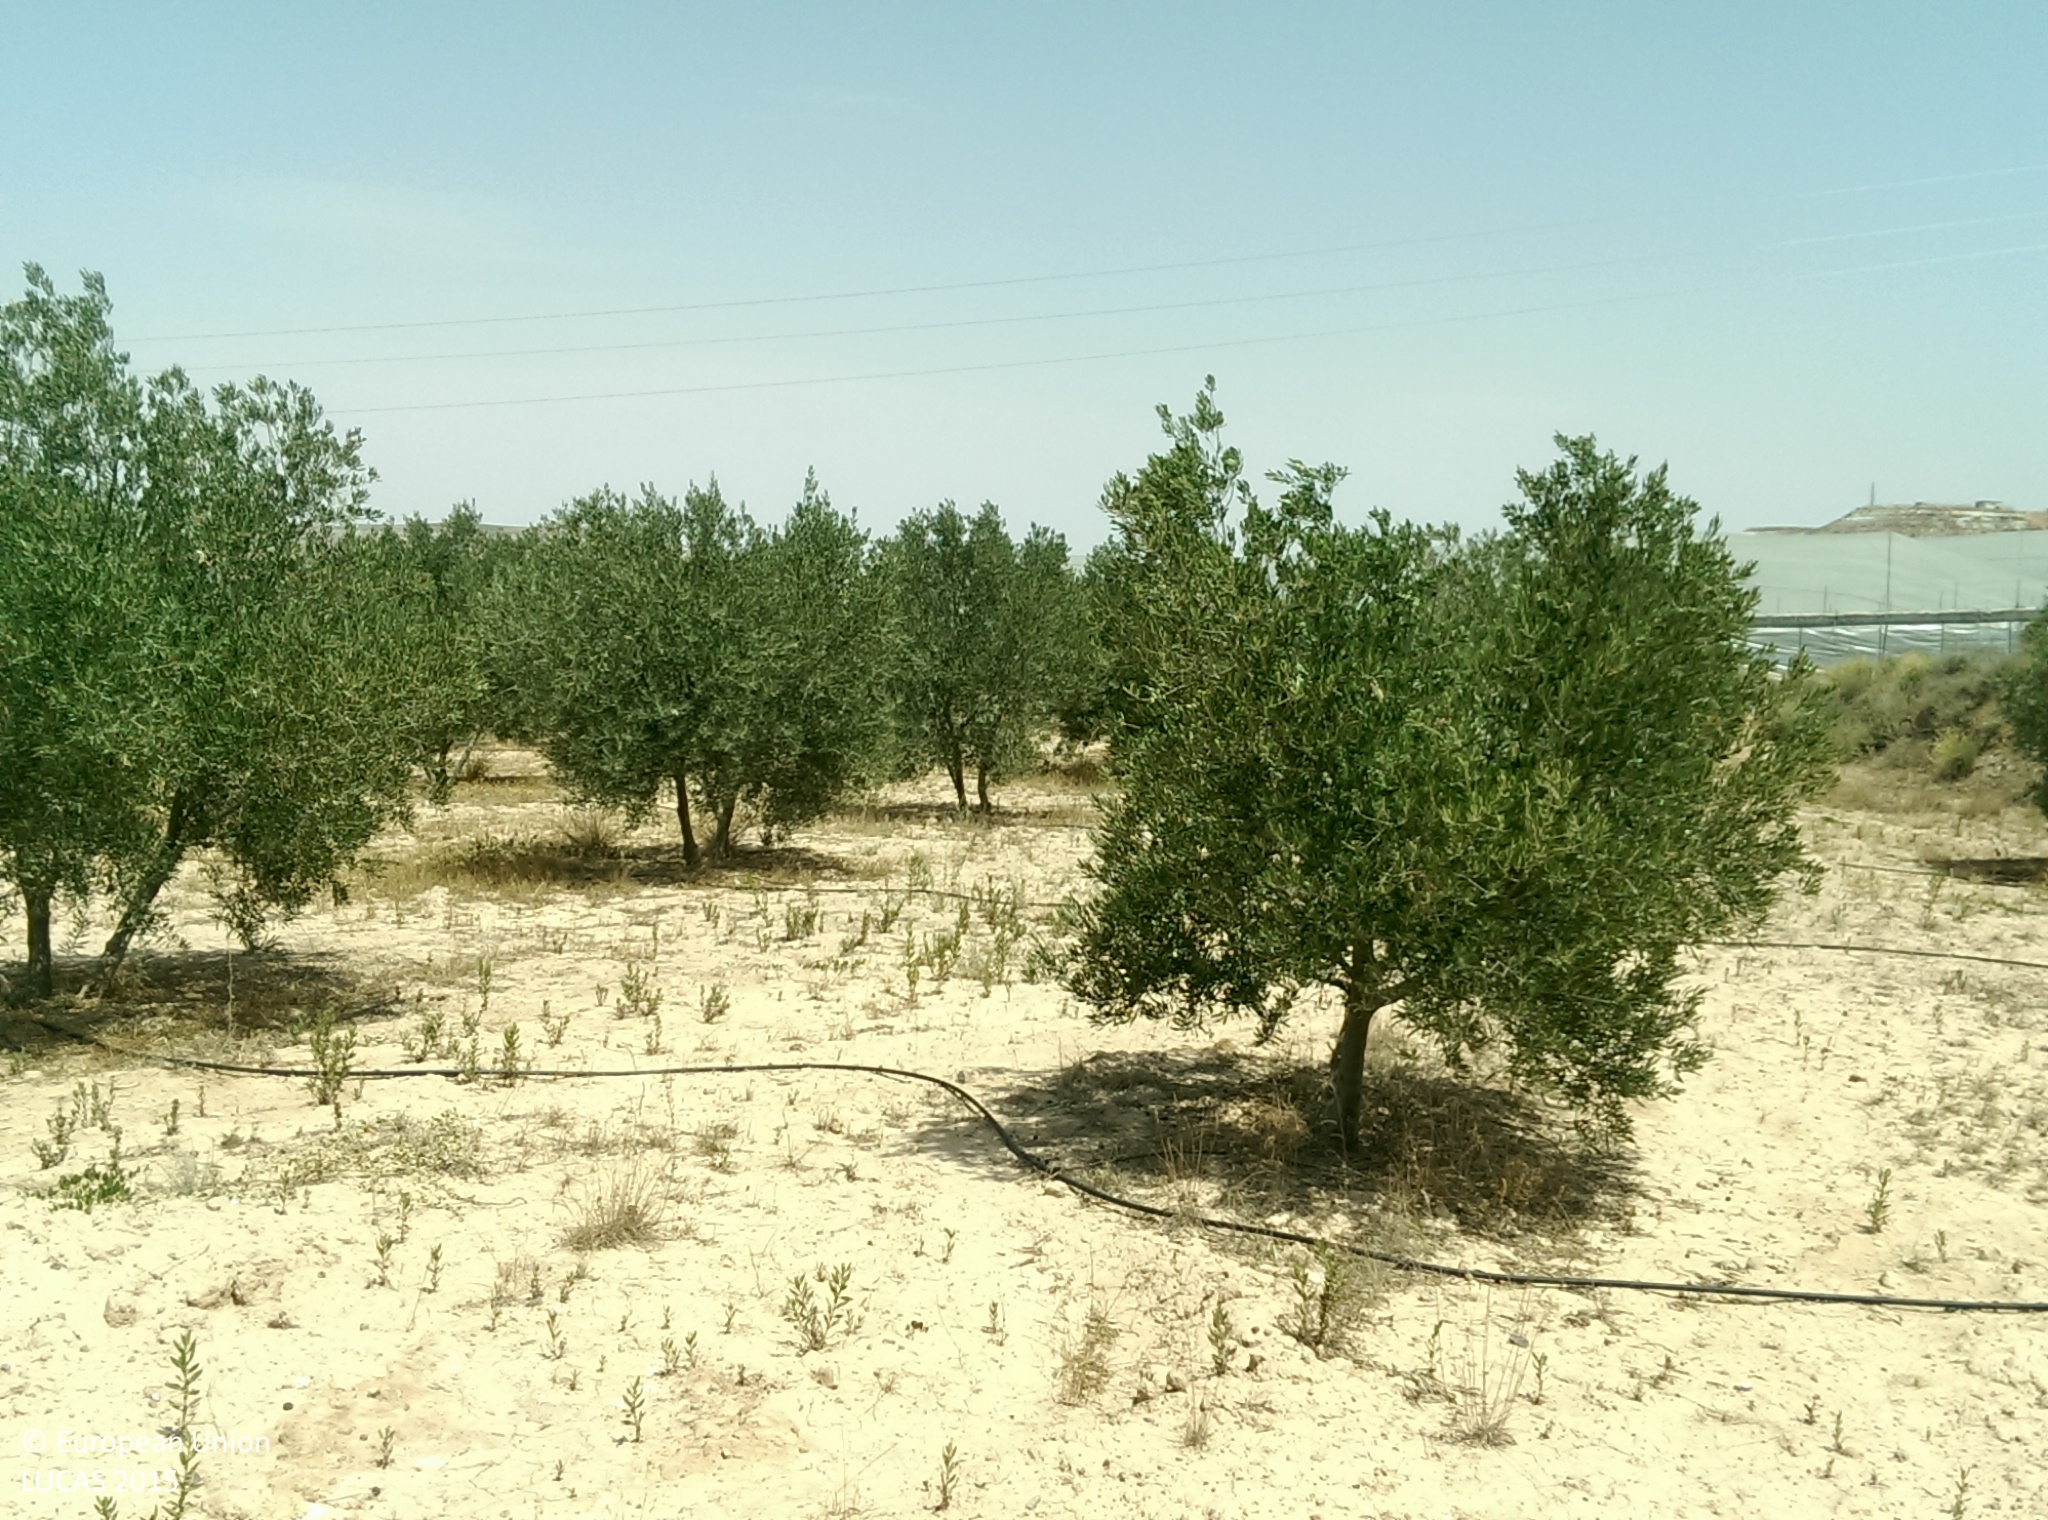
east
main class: Cropland
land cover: Olive groves
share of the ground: 25 - 50 %
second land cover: Other bare soil
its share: > 75 %
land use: Agriculture (excluding fallow land and kitchen gardens)
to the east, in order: Olive groves; Other bare soil; Fences; Tracks; Electric lines; Tracks; Grass margins; Fences; Tracks; Artificial constructions in urban areas; Spontaneously vegetated surfaces; Fences; Grass margins; Tracks; Grass margins; Shrubland without tree cover; Grass margins; Spontaneously vegetated surfaces; Grass margins; Tracks; Grass margins; Olive groves
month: July
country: ES
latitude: 37.5313
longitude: -2.8549
